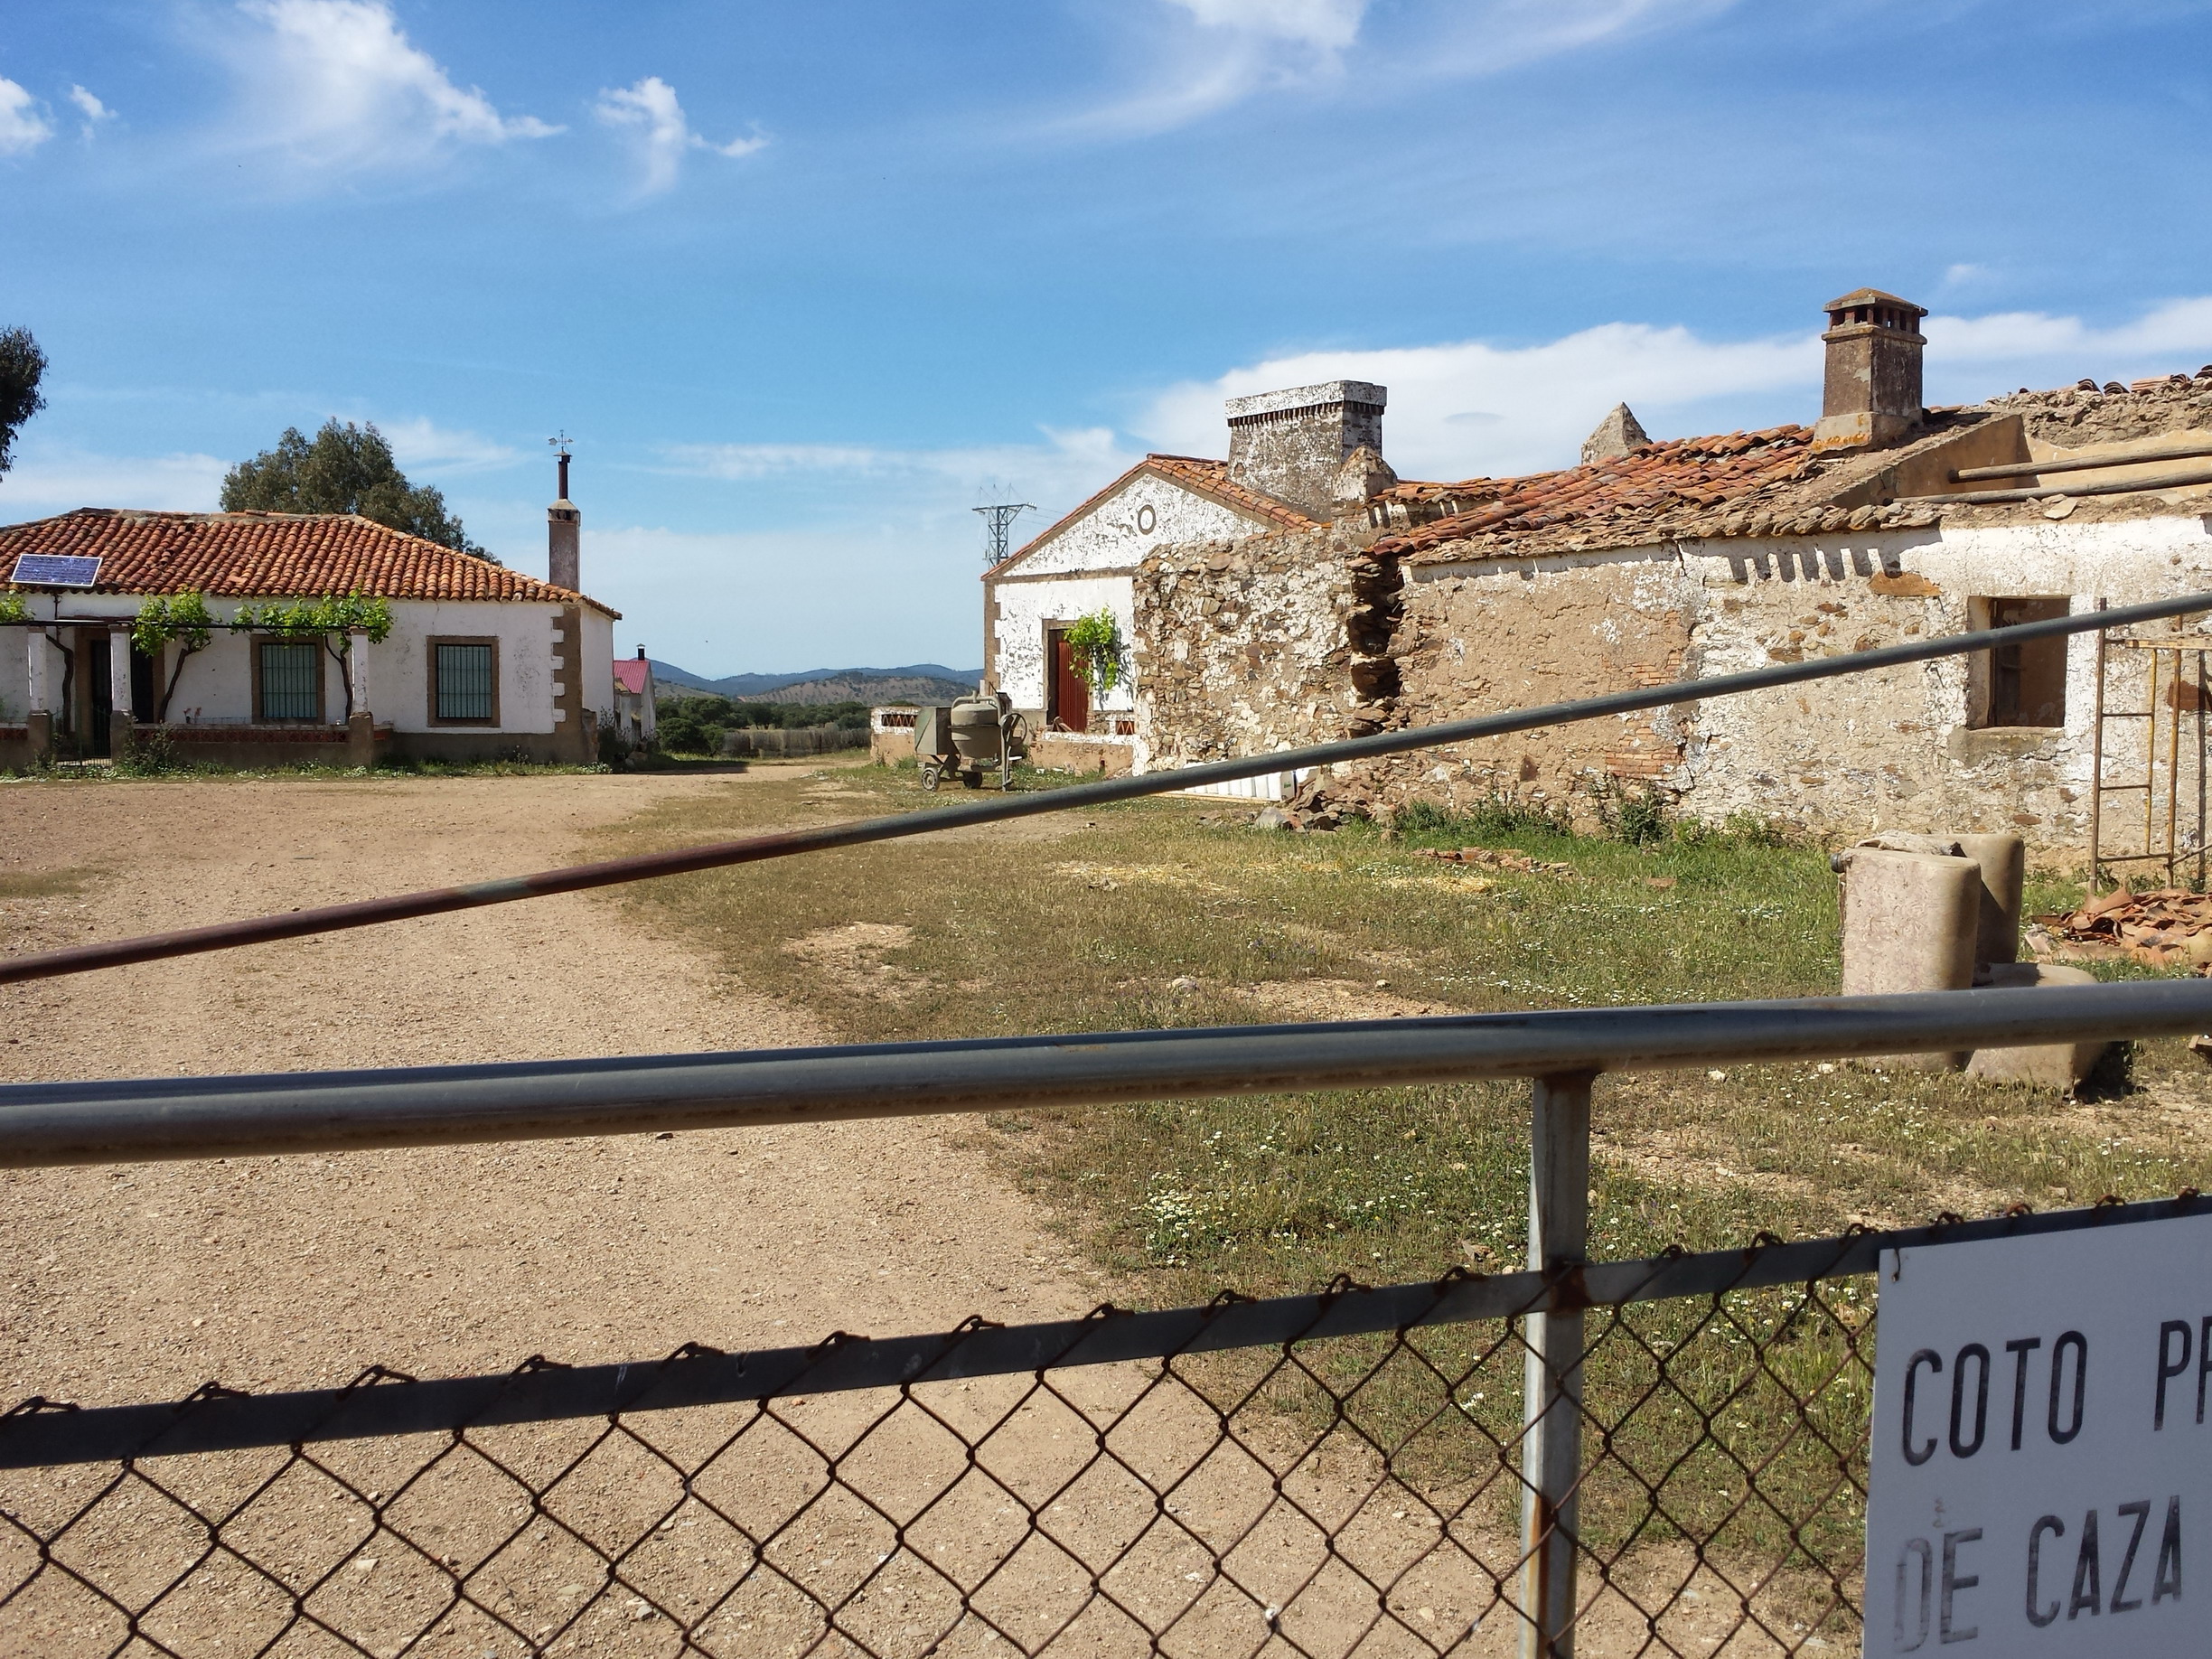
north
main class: Woodland
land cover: Broadleaved woodland
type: broadleaved evergreen forest
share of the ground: 25 - 50 %
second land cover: Grassland without tree/shrub cover
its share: > 75 %
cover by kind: herbaceous plants 65 %, broadleaved forest trees 35 %
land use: Forestry
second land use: Agriculture (excluding fallow land and kitchen gardens)
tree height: > 5 m
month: May
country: ES
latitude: 39.5152
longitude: -7.1726
